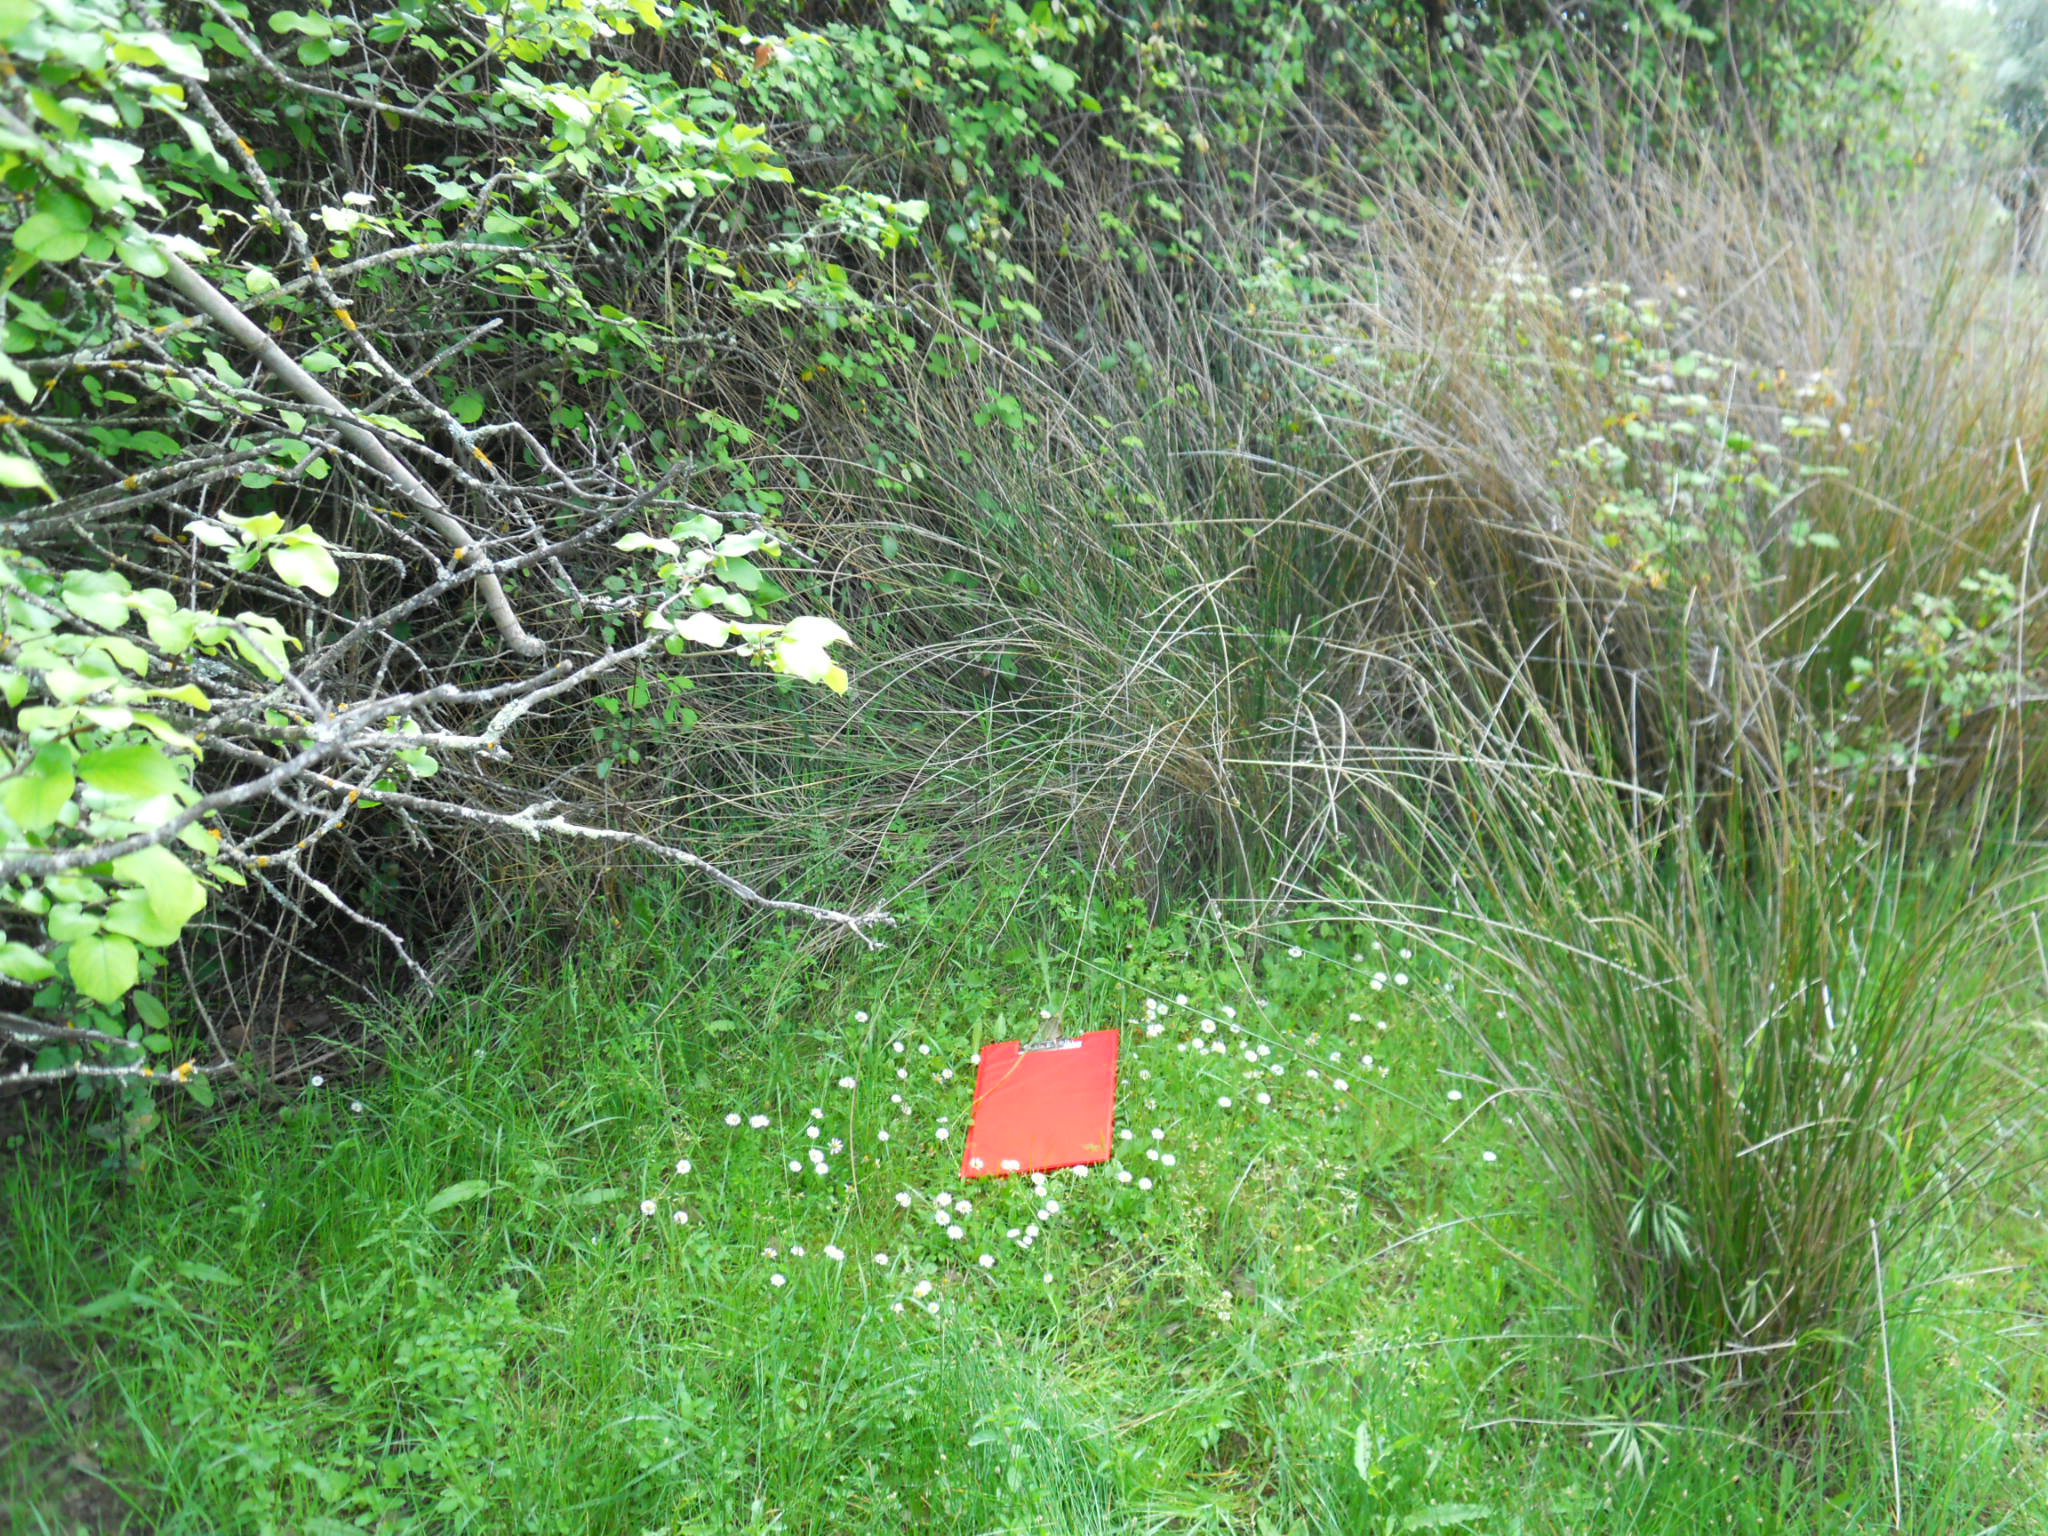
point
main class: Shrubland
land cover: Shrubland with sparse tree cover
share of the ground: > 75 %
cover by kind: shrubs 80 %, herbaceous plants 15 %, broadleaved forest trees 5 %
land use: Agriculture (excluding fallow land and kitchen gardens)
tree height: > 5 m
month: May
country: ES
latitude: 39.1616
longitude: -6.9835
